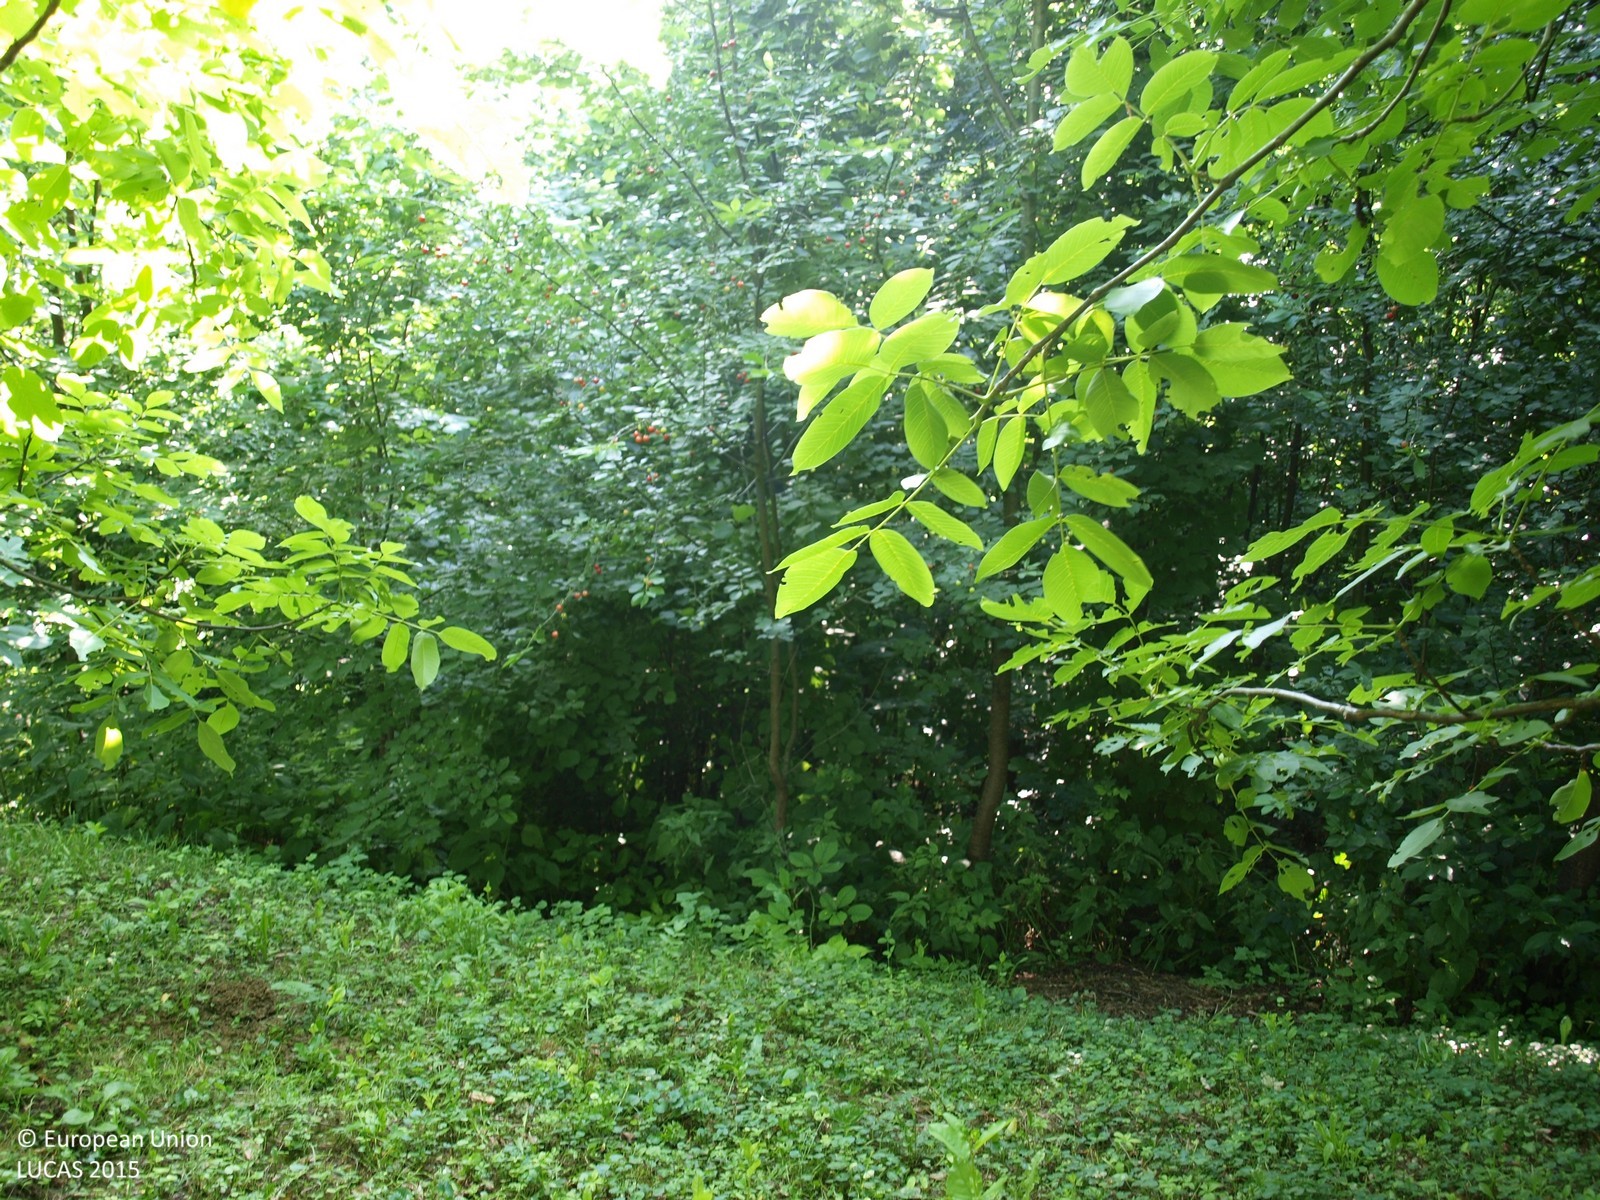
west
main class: Cropland
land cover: Nuts trees
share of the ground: 50 - 75 %
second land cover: Grassland without tree/shrub cover
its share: > 75 %
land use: Agriculture (excluding fallow land and kitchen gardens)
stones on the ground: < 10 %
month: June
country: HR
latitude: 46.1620
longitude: 16.3584
